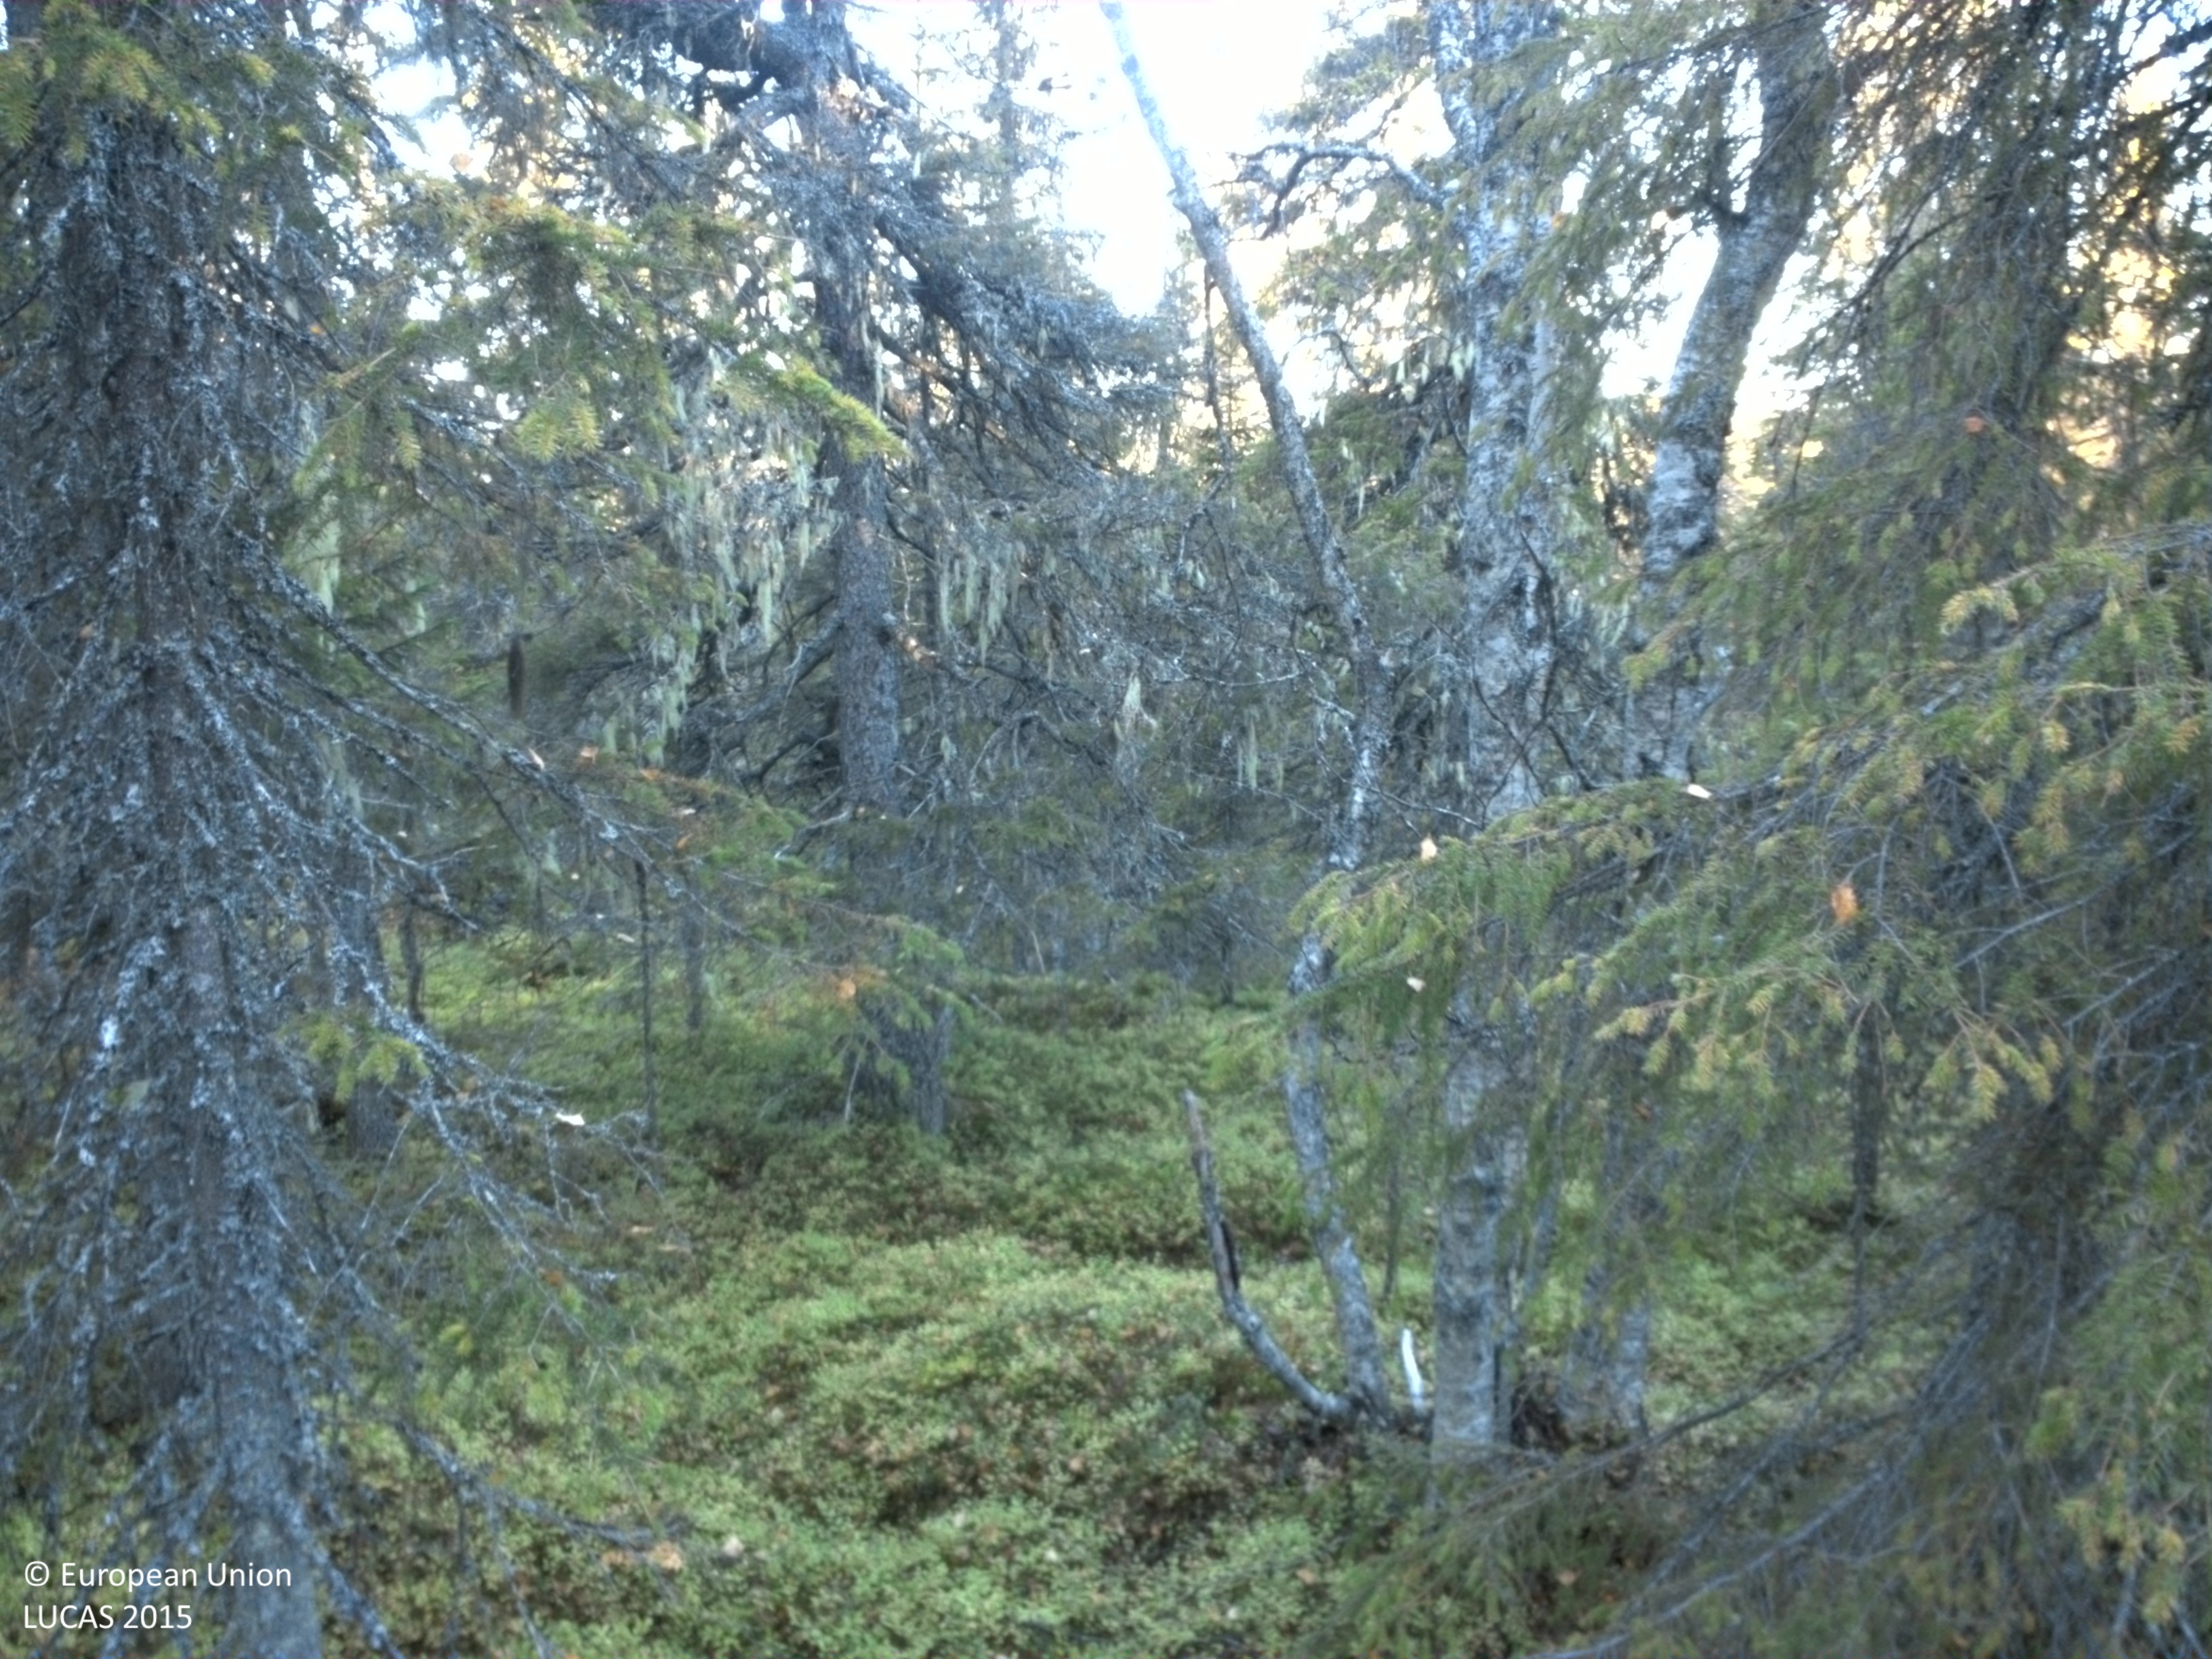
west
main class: Woodland
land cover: Spruce dominated mixed woodland
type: boreal forest
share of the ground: 25 - 50 %
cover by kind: coniferous forest trees 30 %, shrubs 30 %, broadleaved forest trees 20 %, lichens and mosses 10 %, herbaceous plants 5 %, consolidated bare surface 5 %
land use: Forestry
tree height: > 5 m
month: October
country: SE
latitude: 64.8763
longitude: 17.4582
